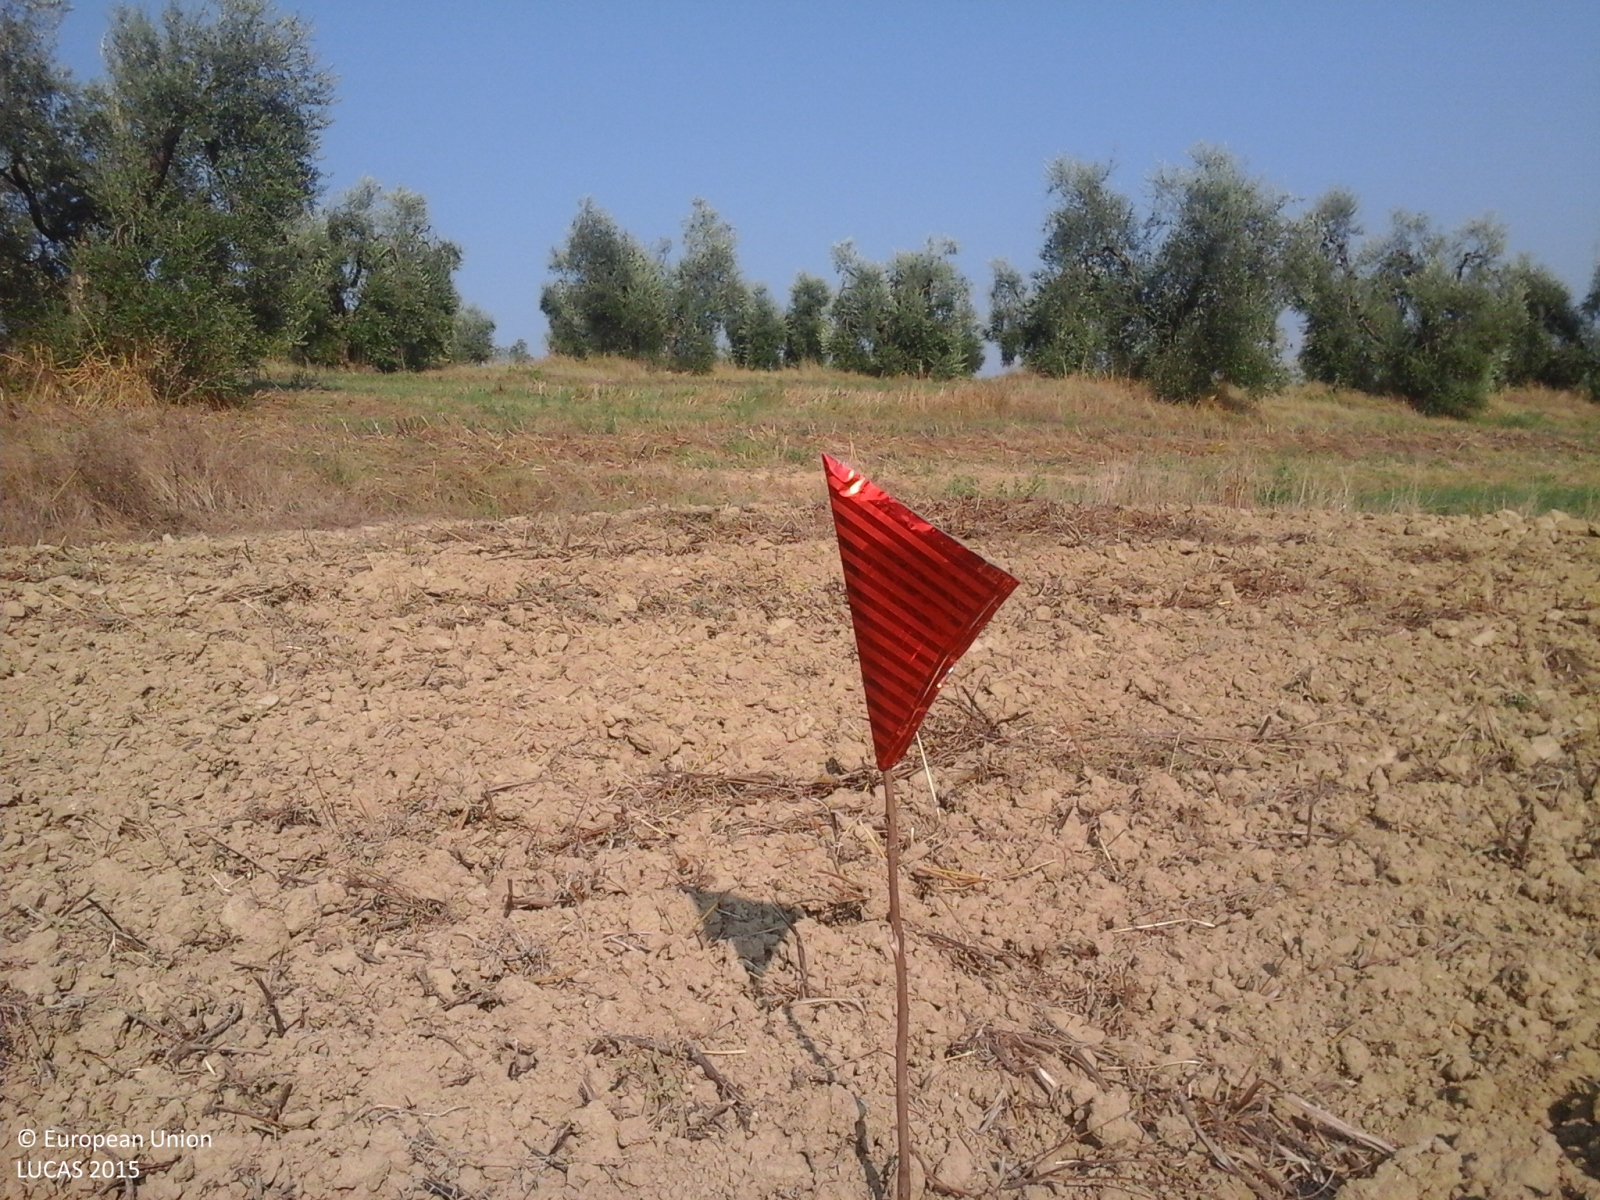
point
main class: Cropland
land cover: Sunflower
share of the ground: 10 - 25 %
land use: Agriculture (excluding fallow land and kitchen gardens)
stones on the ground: < 10 %
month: August
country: IT
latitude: 42.5377
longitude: 12.2937
